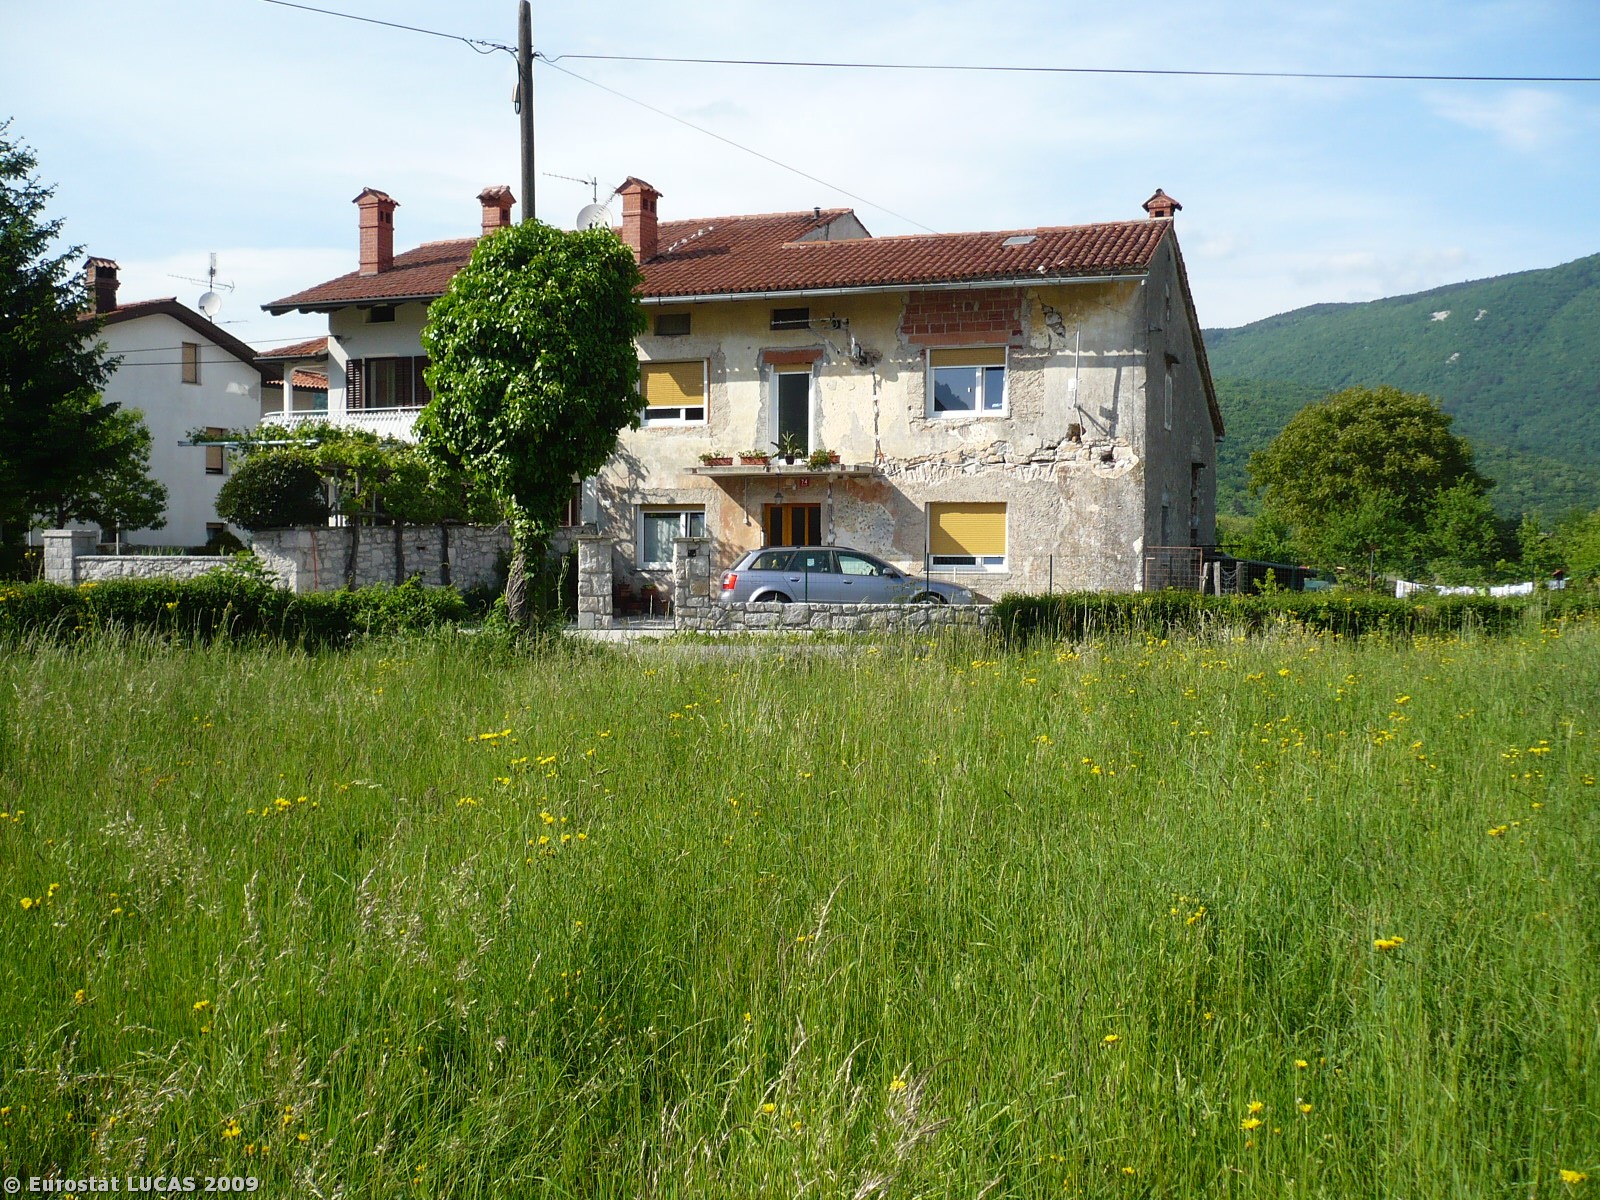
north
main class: Grassland
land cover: Grassland without tree/shrub cover
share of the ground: > 75 %
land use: Agriculture (excluding fallow land and kitchen gardens)
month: May
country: SI
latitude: 45.9995
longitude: 13.6762
